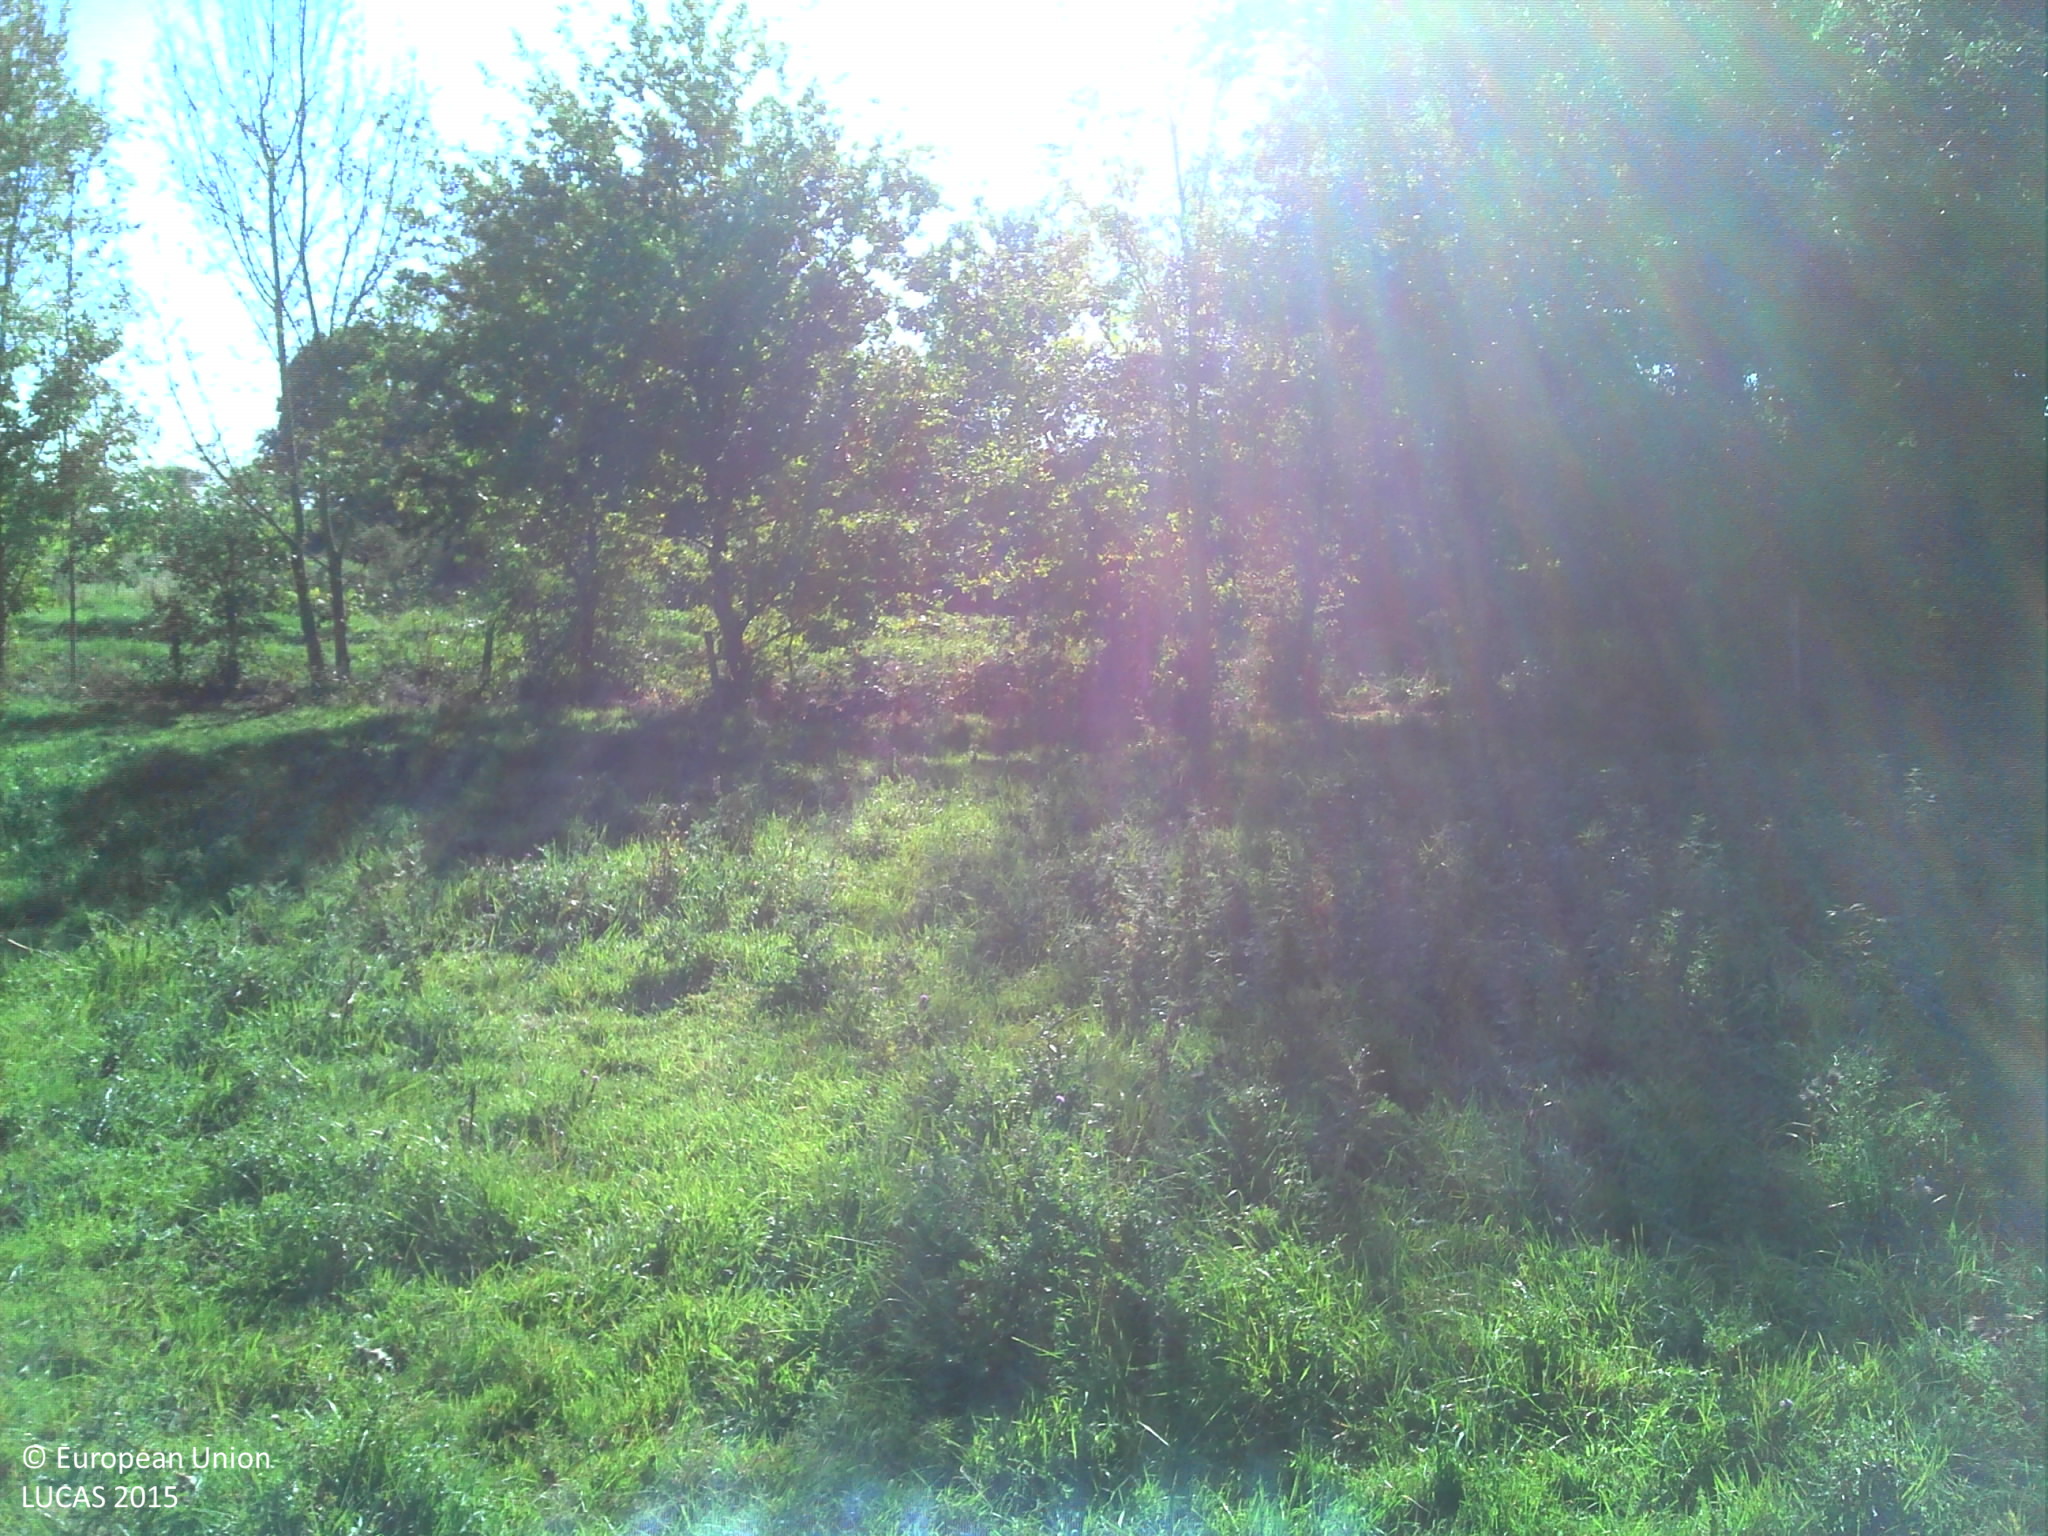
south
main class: Grassland
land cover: Grassland without tree/shrub cover
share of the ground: > 75 %
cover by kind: herbaceous plants 100 %
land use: Agriculture (excluding fallow land and kitchen gardens)
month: October
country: FR
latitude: 46.8421
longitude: -1.4602
